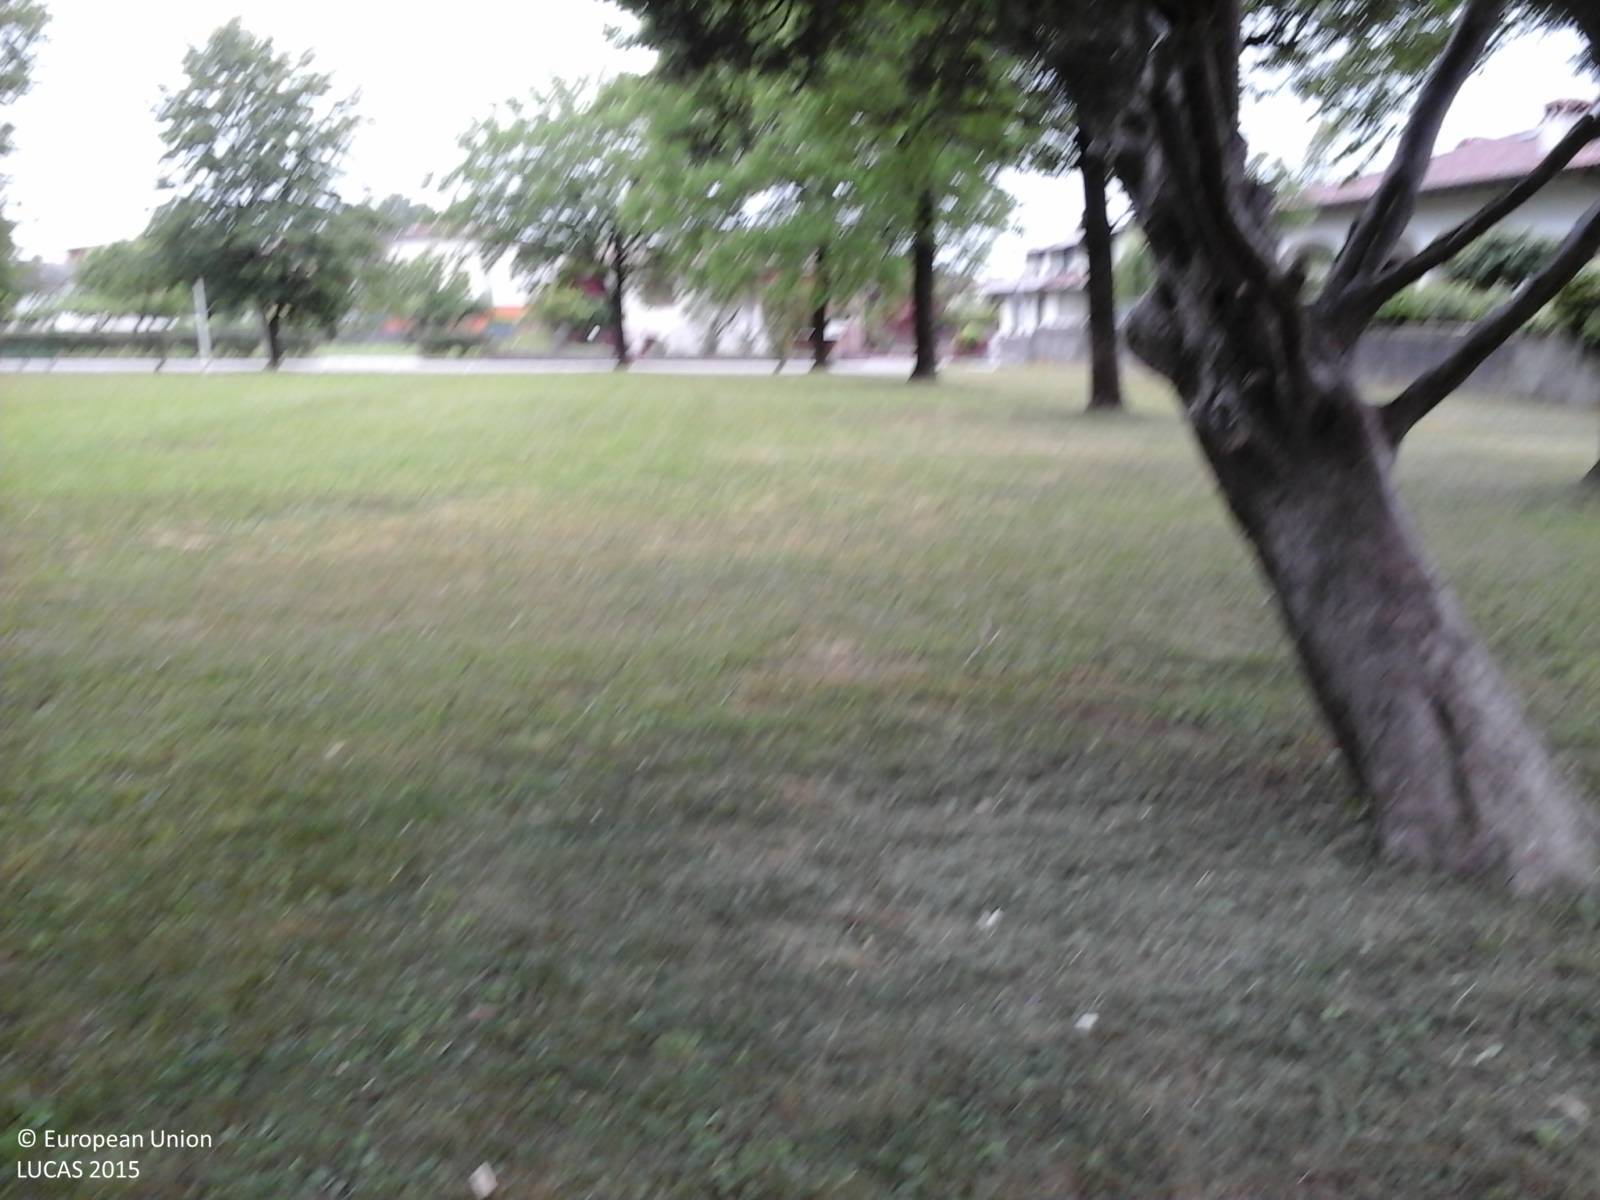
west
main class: Woodland
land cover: Broadleaved woodland
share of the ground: > 75 %
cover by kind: broadleaved forest trees 80 %, herbaceous plants 20 %
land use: Amenities, museums, leisure
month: May
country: IT
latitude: 46.0834
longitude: 13.3199
